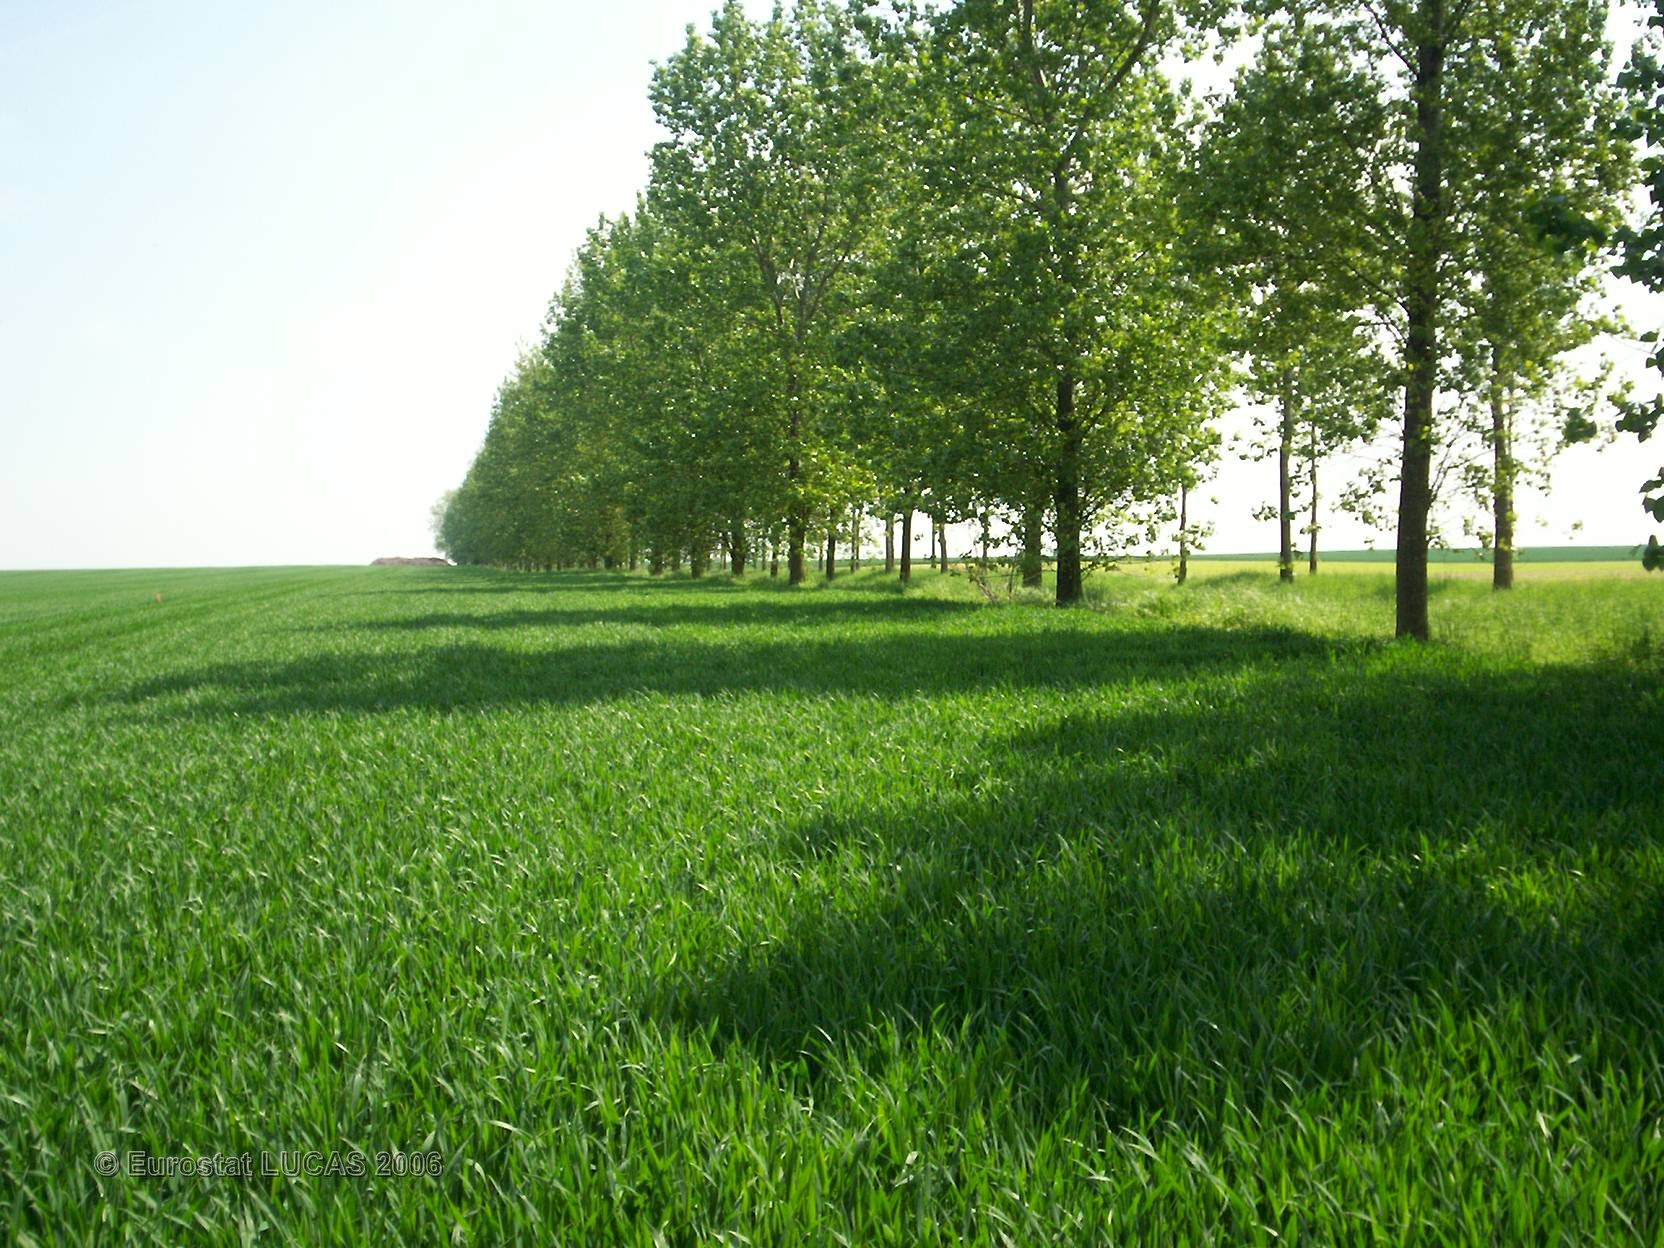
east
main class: Cropland
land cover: Common wheat
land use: Agriculture (excluding fallow land and kitchen gardens)
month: May
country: FR
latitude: 48.9807
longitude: 2.7894
